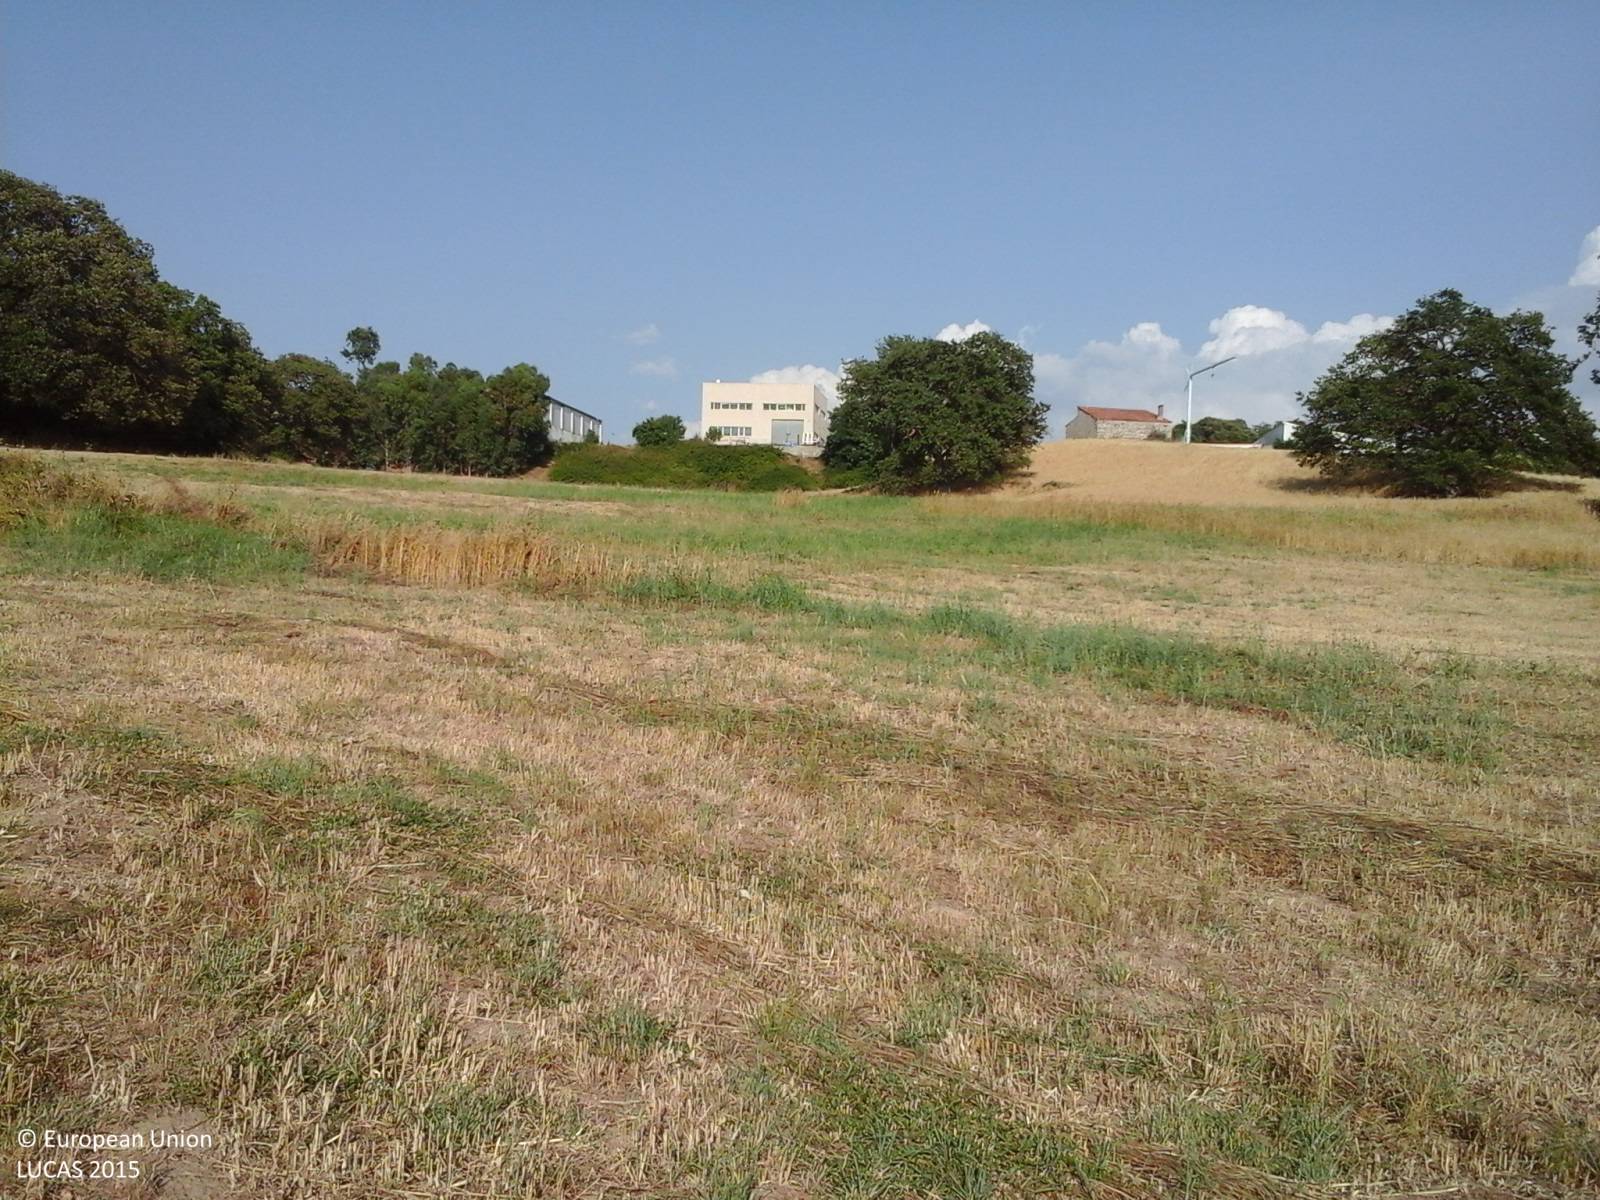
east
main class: Cropland
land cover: Oats
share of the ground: > 75 %
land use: Agriculture (excluding fallow land and kitchen gardens)
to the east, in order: Oats; Barley; Fences; Grass margins; Paved roads, cycling and walking lanes; Artificial constructions; Broadleaved woodland; Spontaneously vegetated surfaces
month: July
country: IT
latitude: 40.0267
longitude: 8.9861
